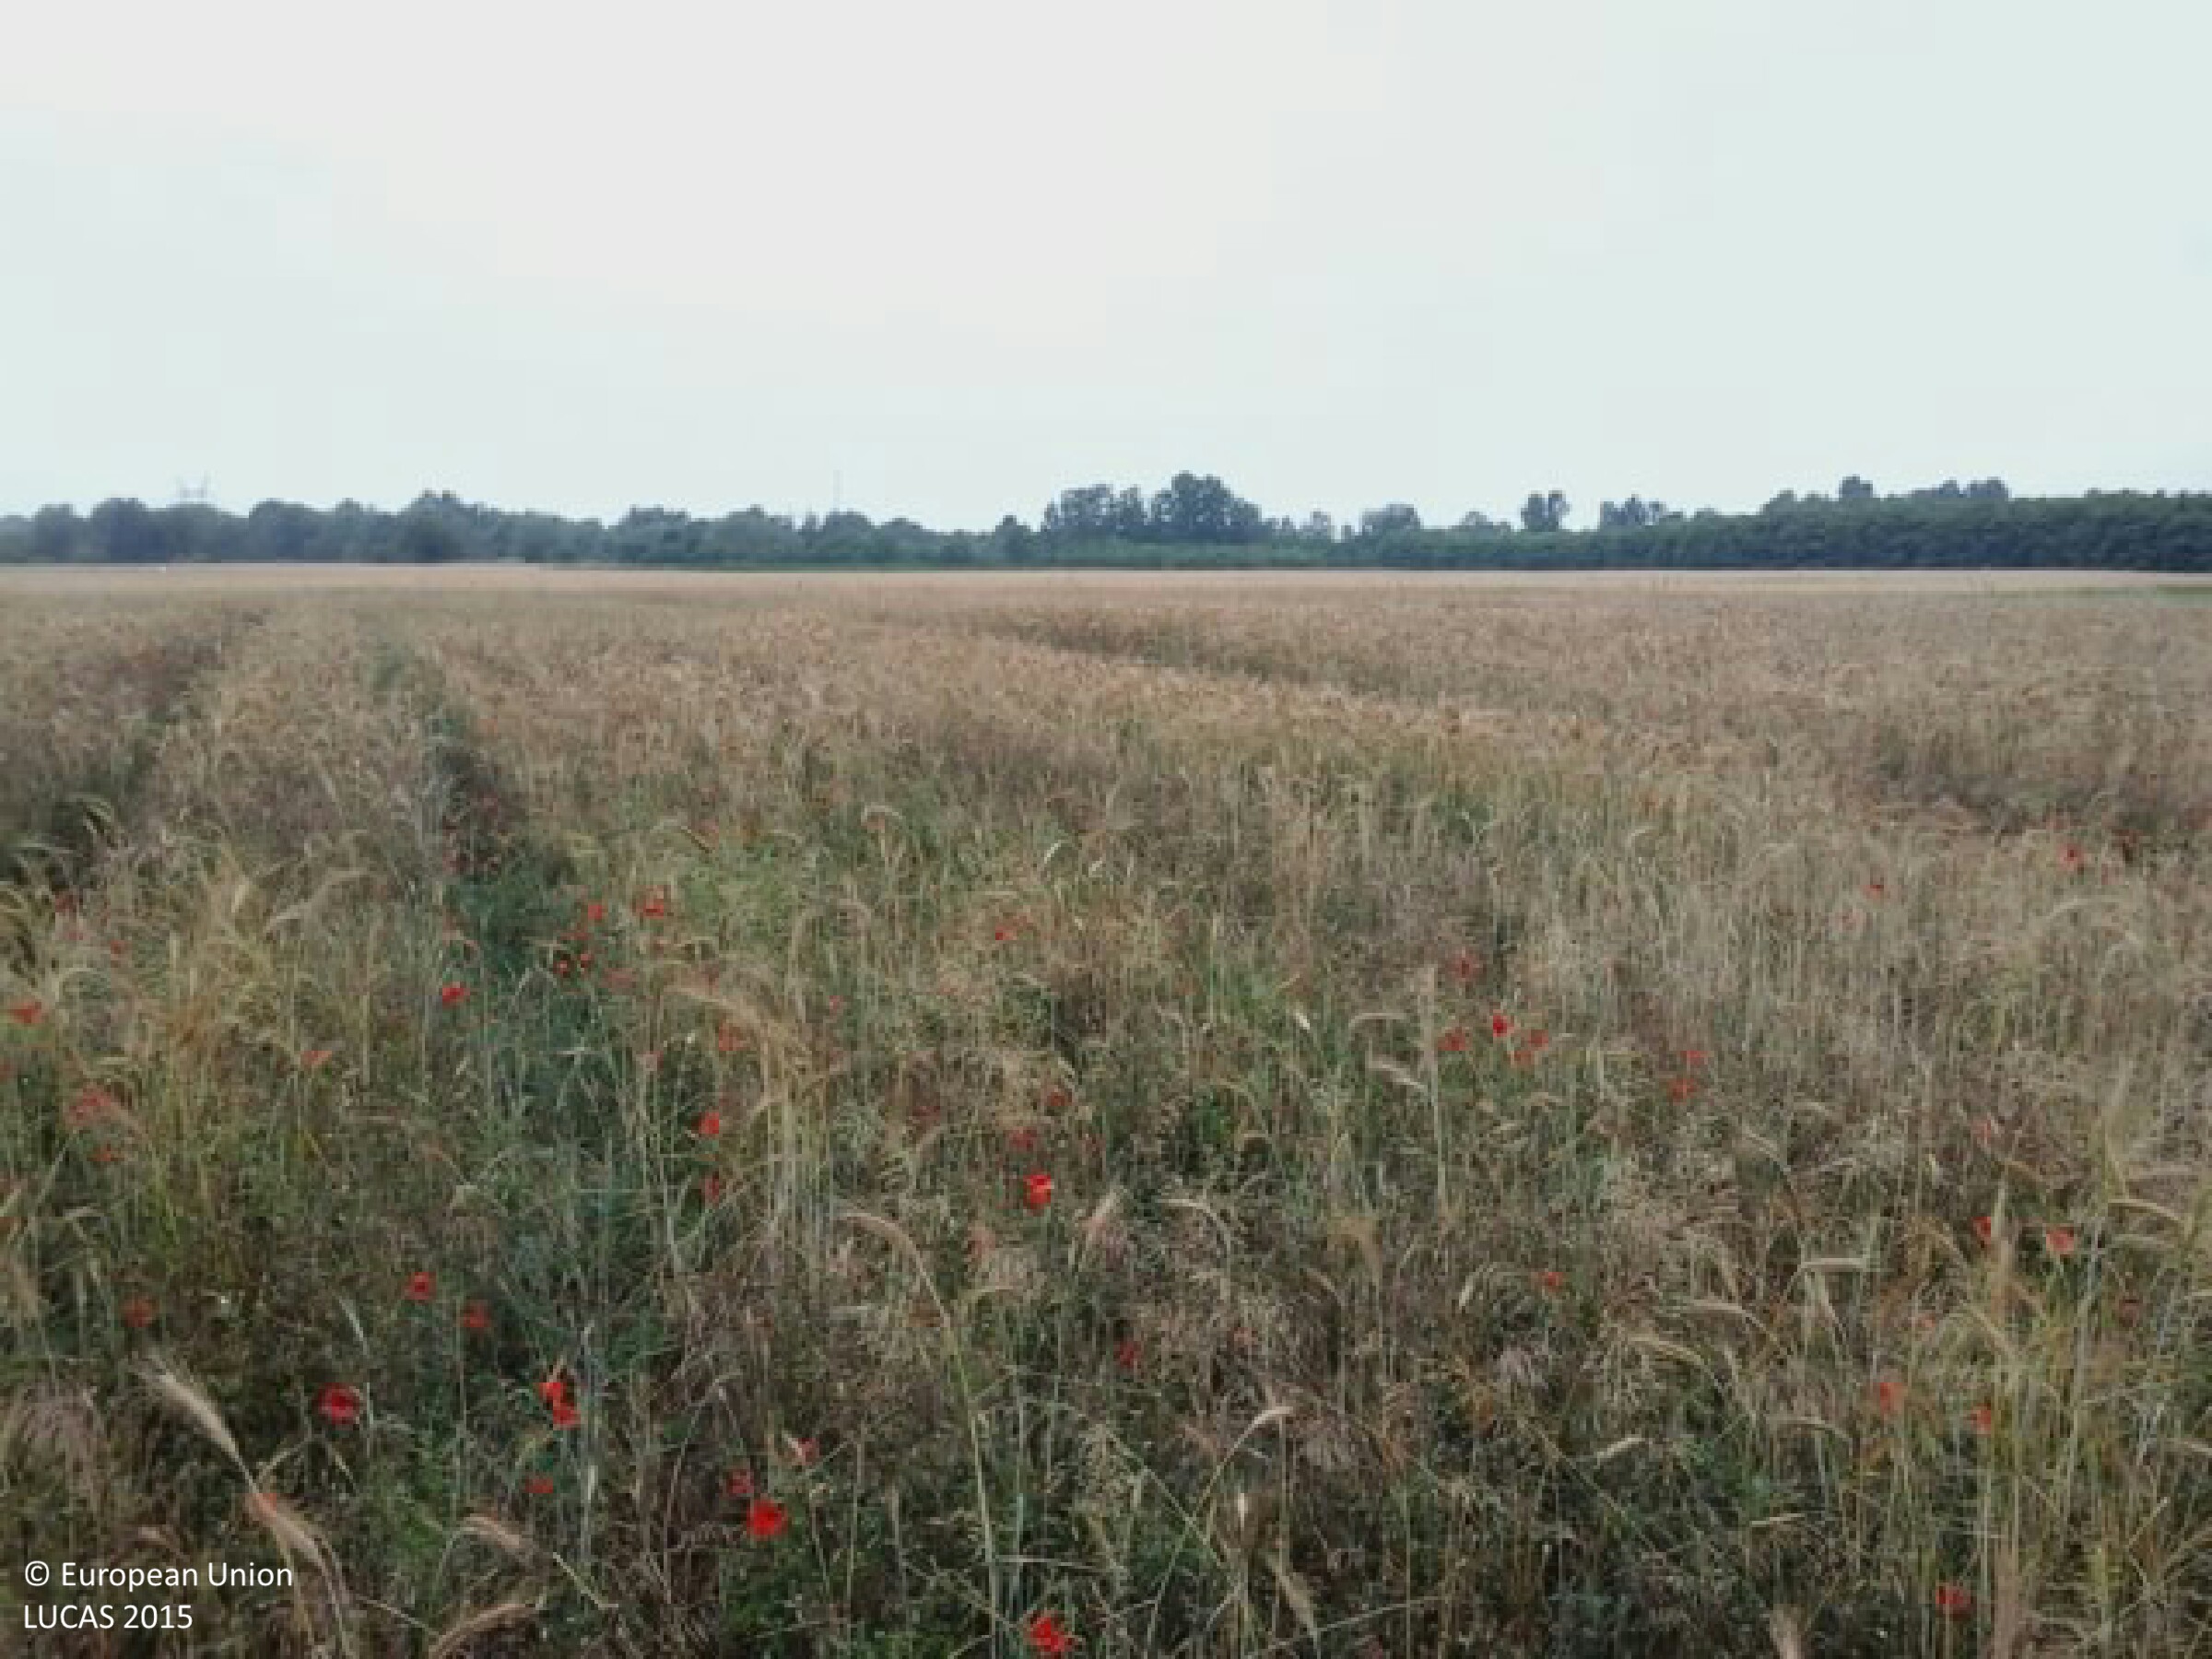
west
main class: Cropland
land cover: Common wheat
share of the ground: > 75 %
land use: Agriculture (excluding fallow land and kitchen gardens)
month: June
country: HU
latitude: 46.3980
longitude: 20.1018
